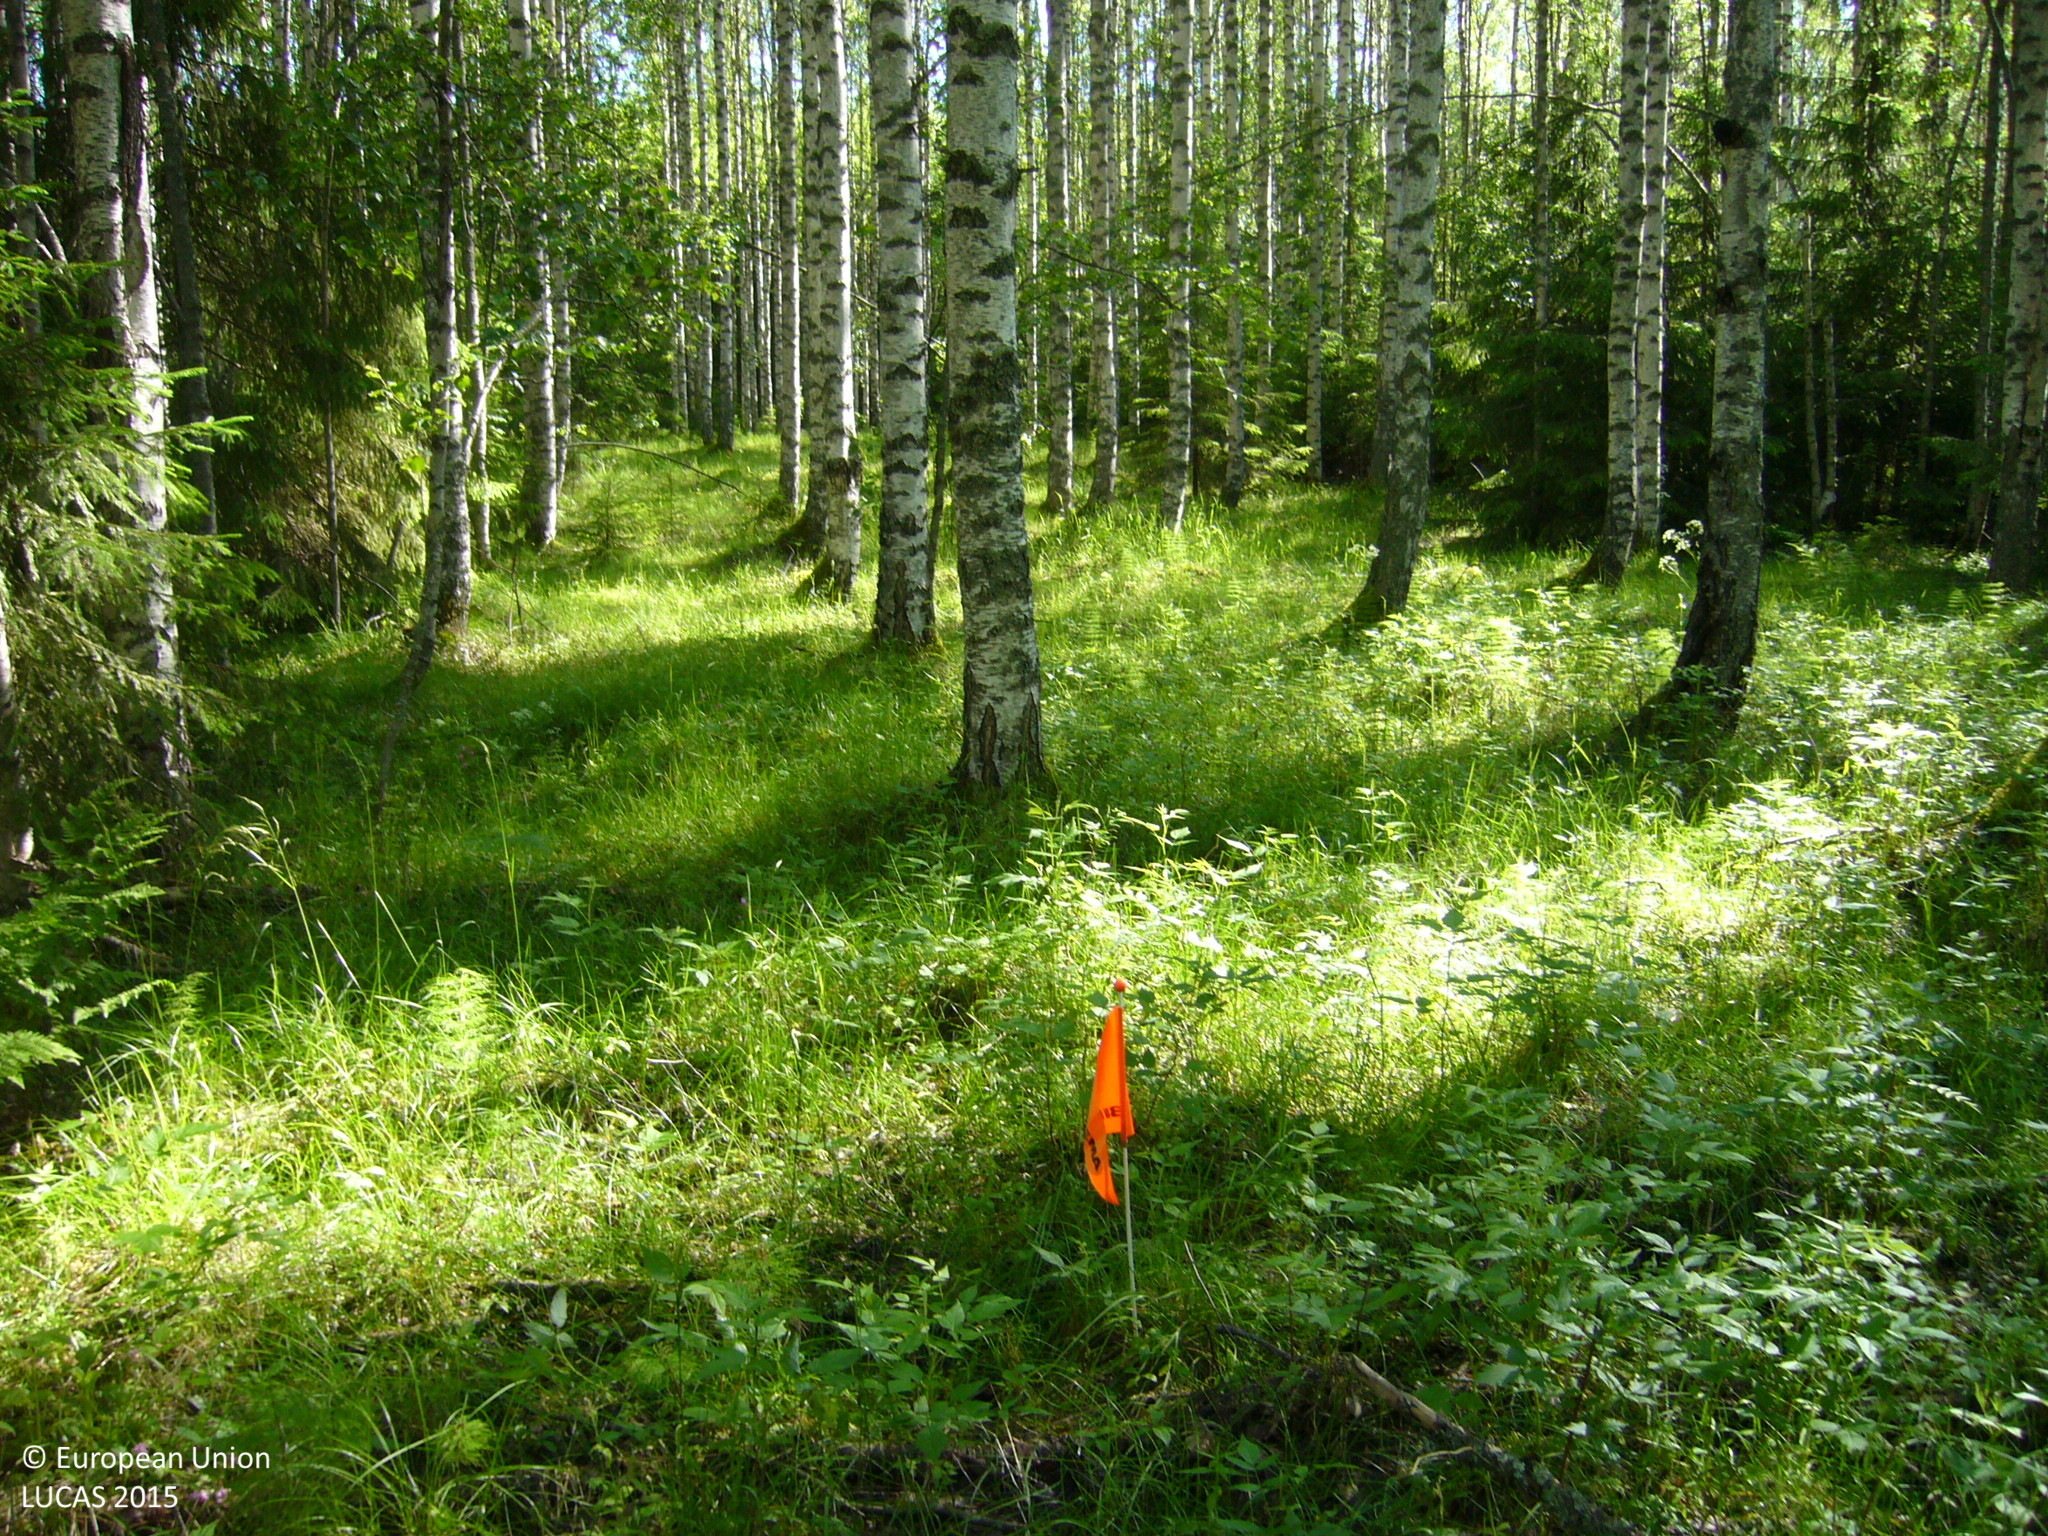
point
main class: Woodland
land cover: Spruce dominated mixed woodland
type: boreal forest
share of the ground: > 75 %
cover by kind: broadleaved forest trees 60 %, coniferous forest trees 25 %, shrubs 15 %
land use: Forestry
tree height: > 5 m
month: June
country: FI
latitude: 63.8240
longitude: 26.4784
